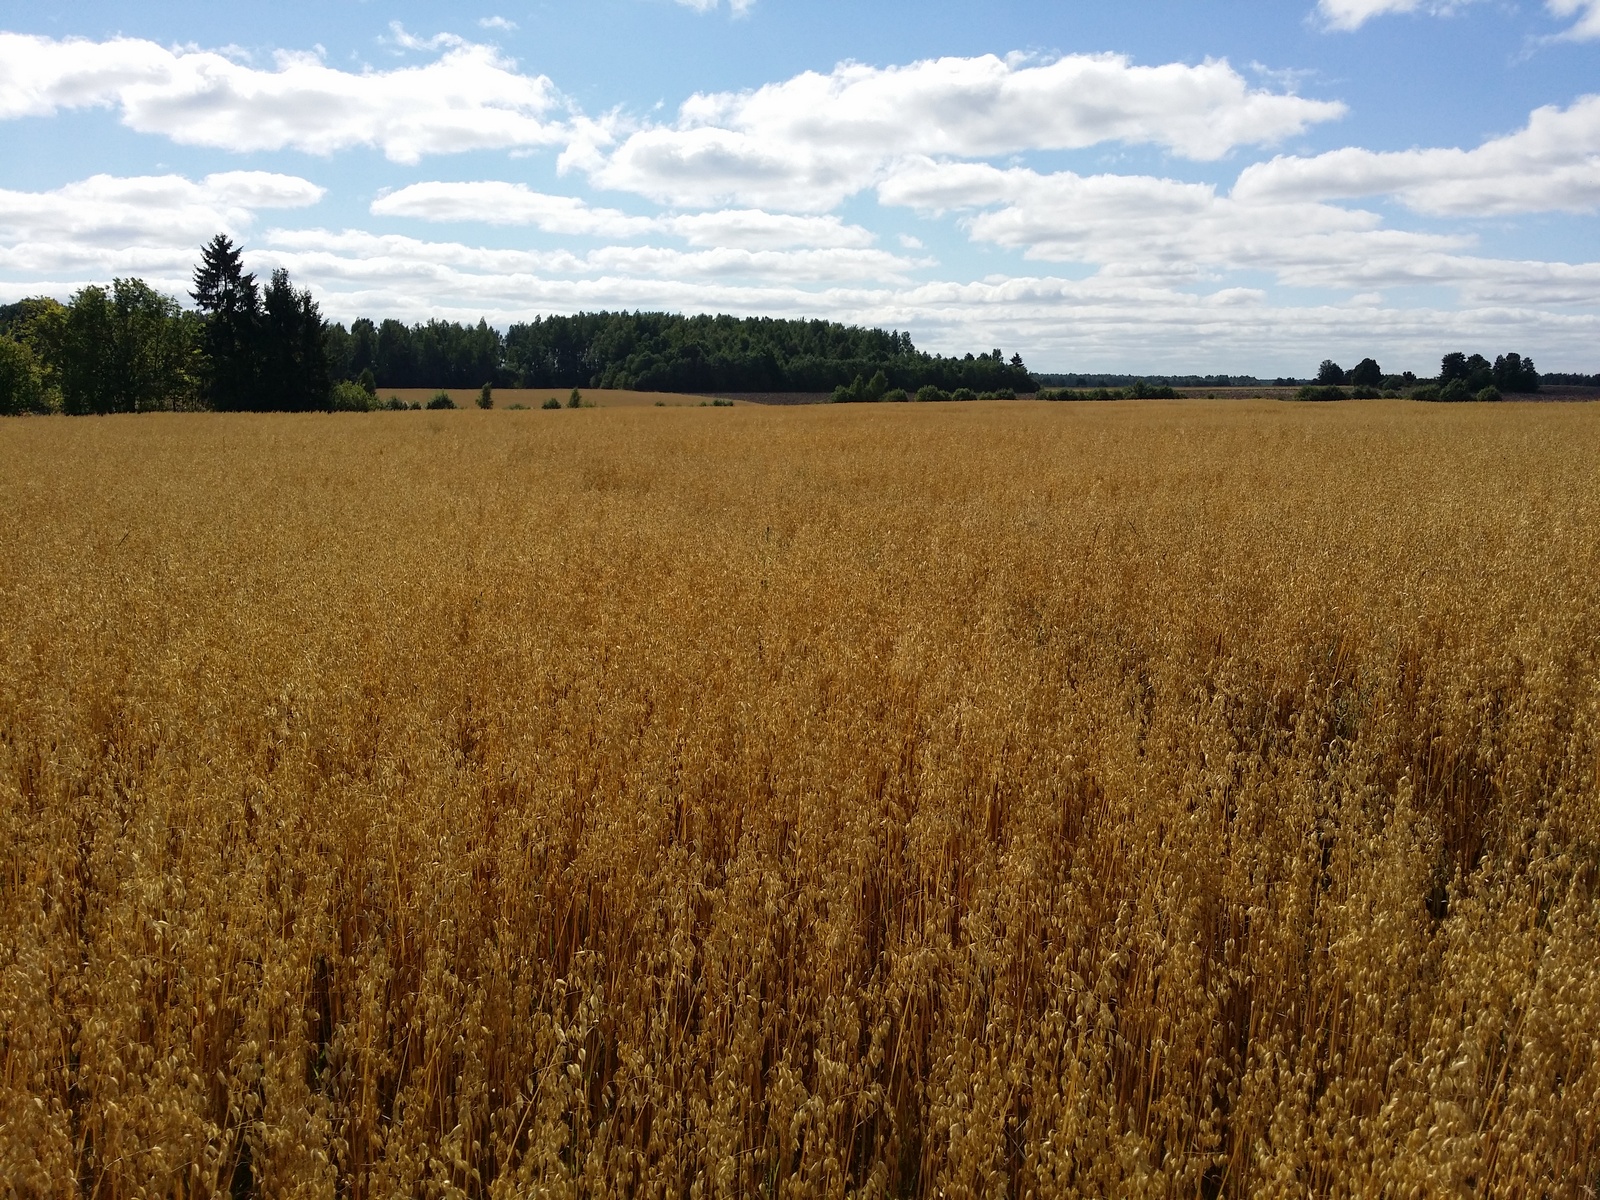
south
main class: Cropland
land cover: Oats
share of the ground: > 75 %
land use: Agriculture (excluding fallow land and kitchen gardens)
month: August
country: LV
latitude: 57.2422
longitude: 27.7657
